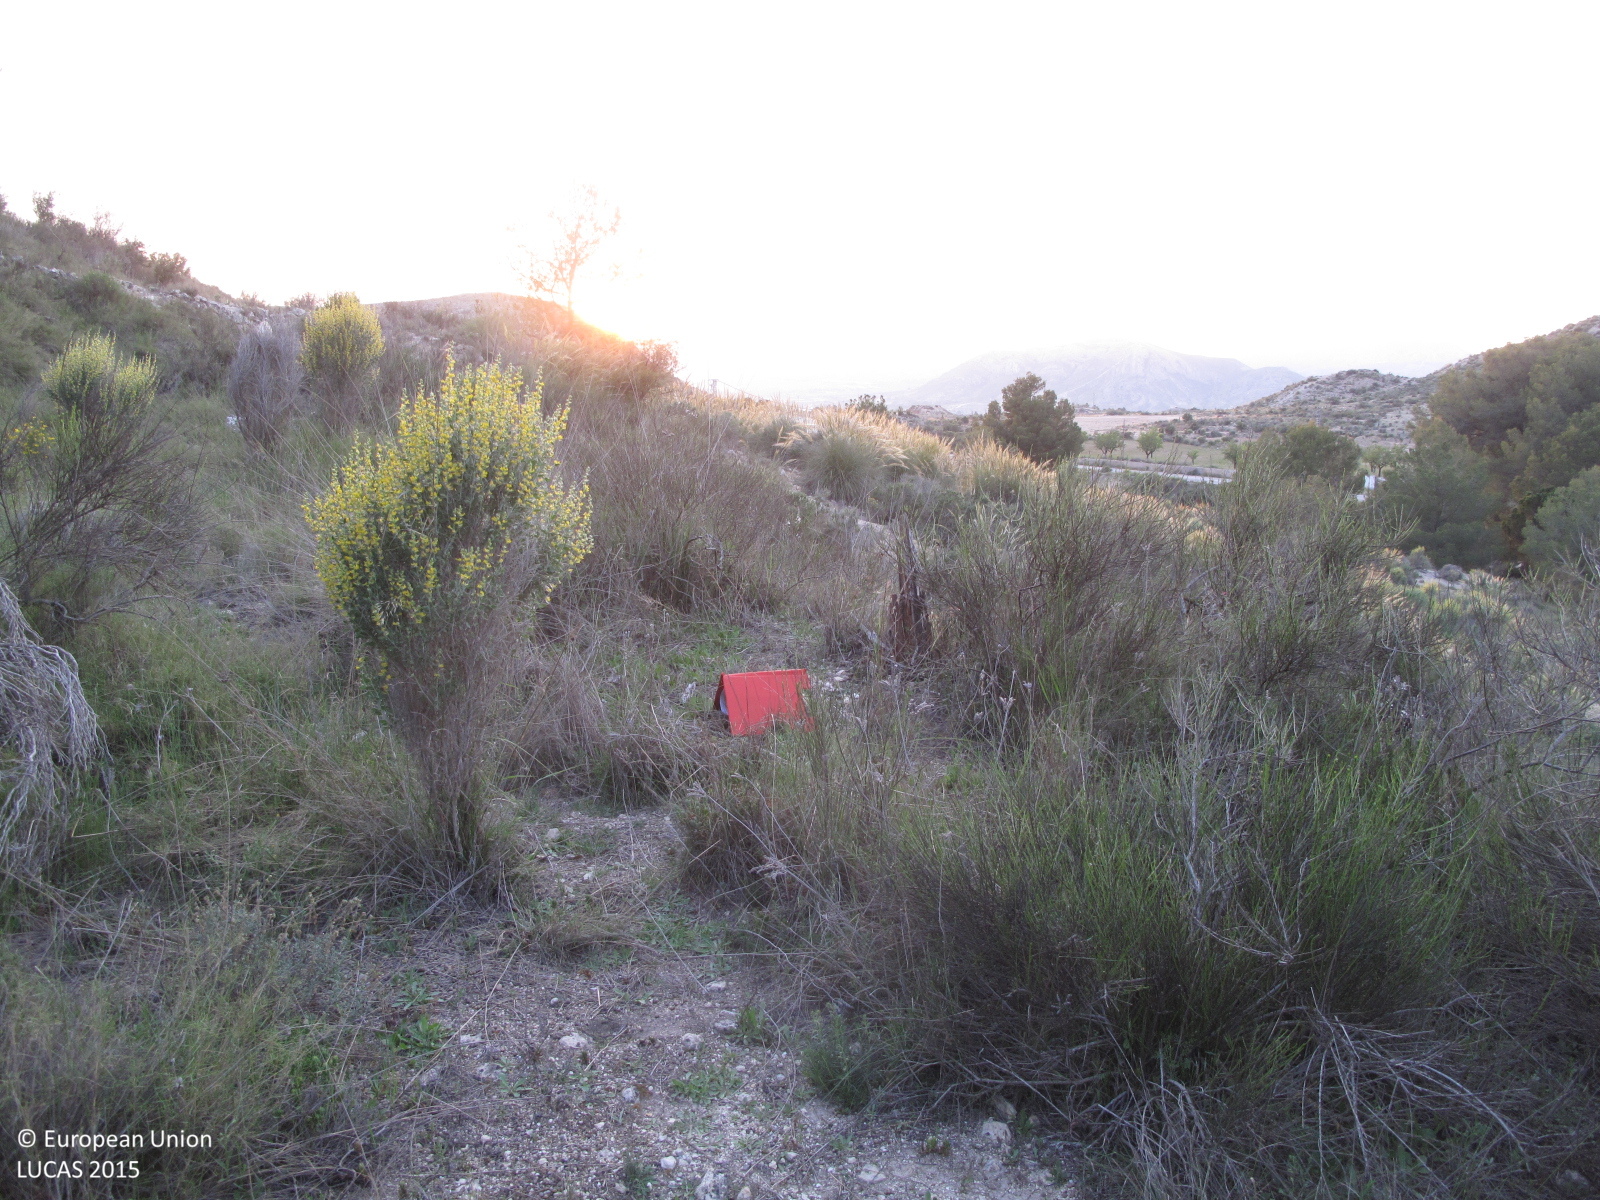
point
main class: Shrubland
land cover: Shrubland without tree cover
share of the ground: 25 - 50 %
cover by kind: herbaceous plants 60 %, shrubs 30 %, consolidated bare surface 10 %
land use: Semi-natural and natural areas not in use
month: April
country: ES
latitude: 38.4498
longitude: -0.7701
